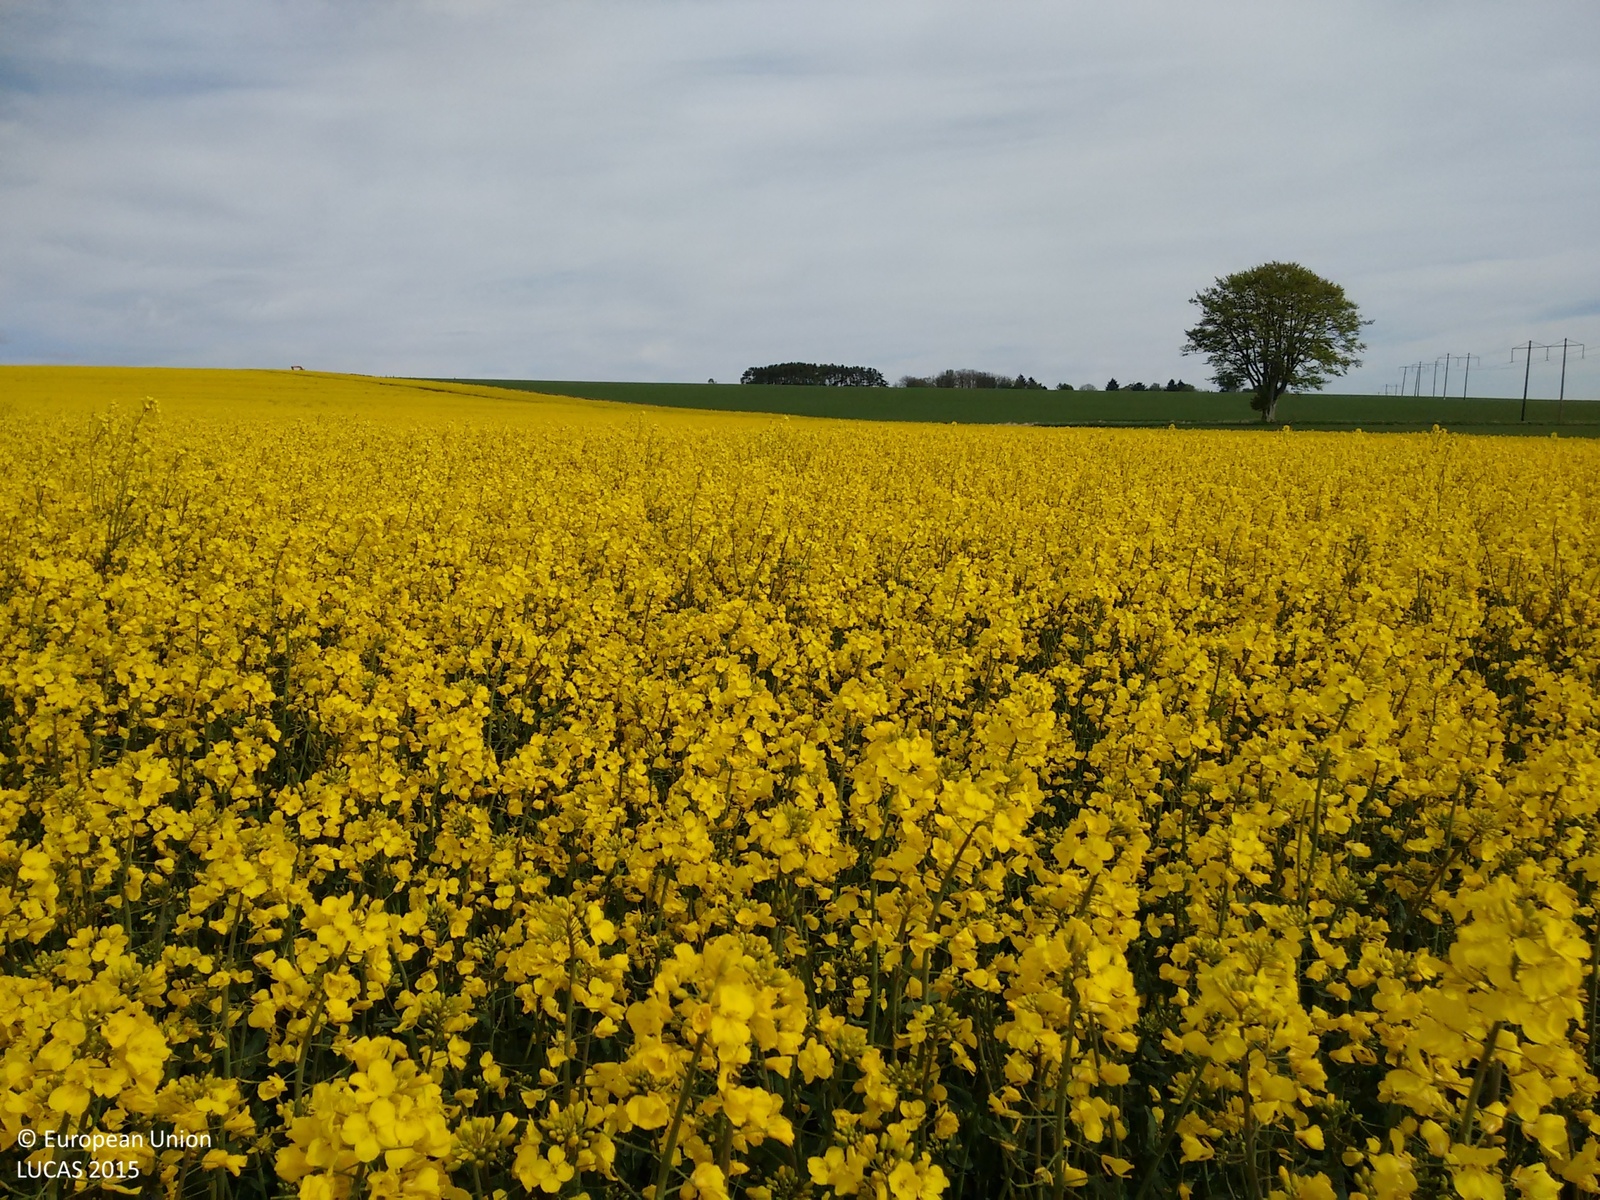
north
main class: Cropland
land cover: Rape and turnip rape
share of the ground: > 75 %
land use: Agriculture (excluding fallow land and kitchen gardens)
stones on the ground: 10 - 25 %
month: May
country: GB
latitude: 56.7066
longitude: -2.6527
